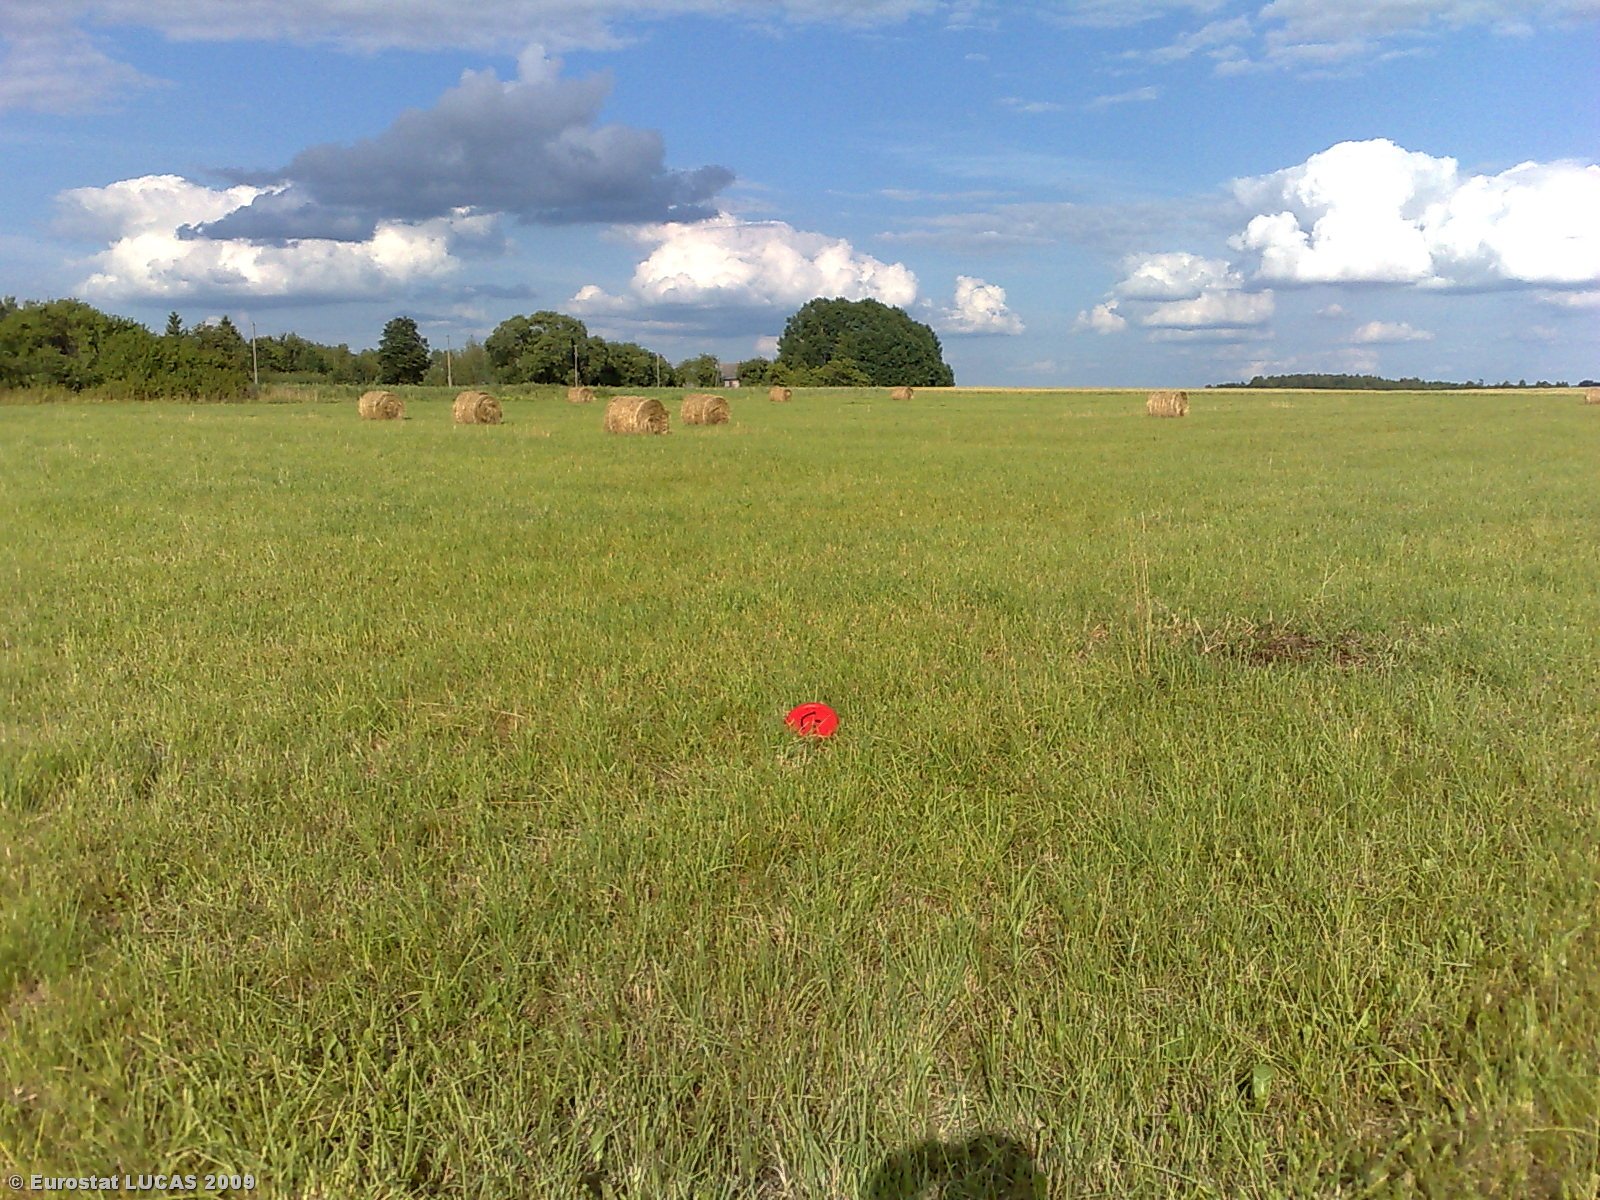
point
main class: Grassland
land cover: Grassland without tree/shrub cover
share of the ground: > 75 %
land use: Agriculture (excluding fallow land and kitchen gardens)
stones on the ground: < 10 %
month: July
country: LT
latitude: 55.7269
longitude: 22.7872
